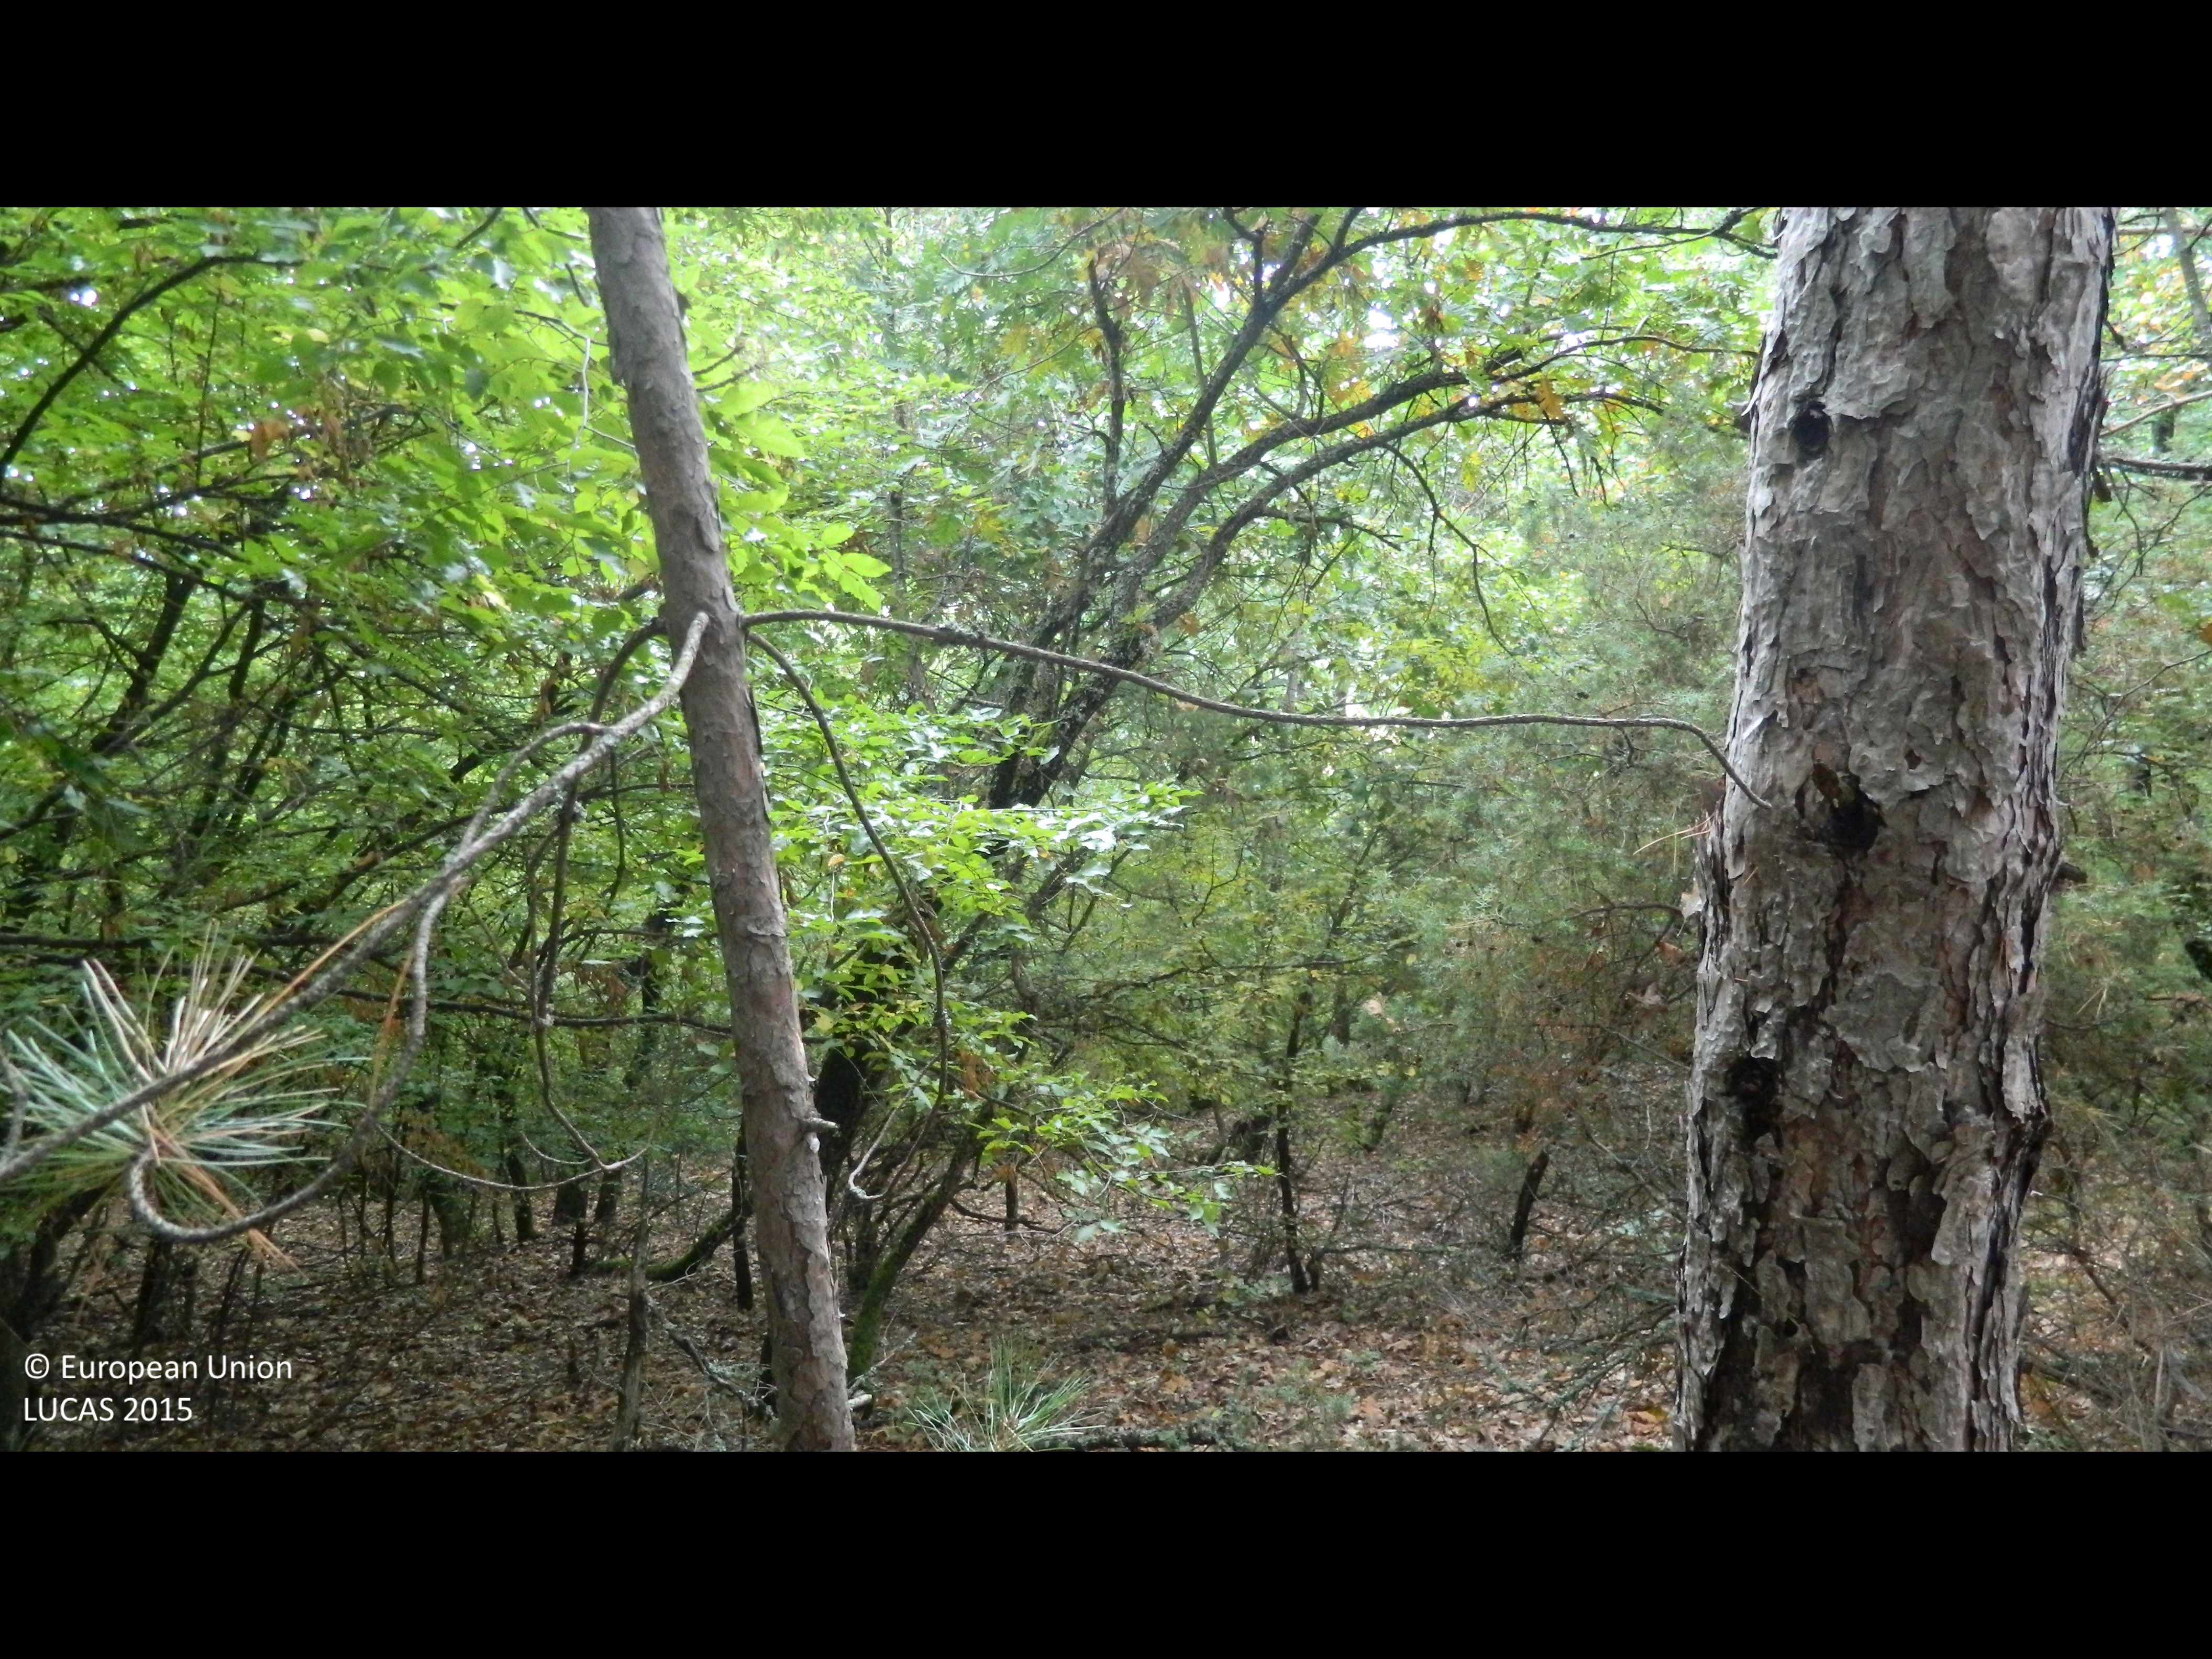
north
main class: Woodland
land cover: Pine dominated mixed woodland
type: hemiboreal forest and nemoral coniferous forest and mixed broadleaved-coniferous forest
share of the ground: > 75 %
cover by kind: coniferous forest trees 65 %, broadleaved forest trees 25 %, shrubs 5 %, unconsolidated bare surface 5 %
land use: Forestry
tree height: > 5 m
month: September
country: BG
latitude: 41.6465
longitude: 25.7817
